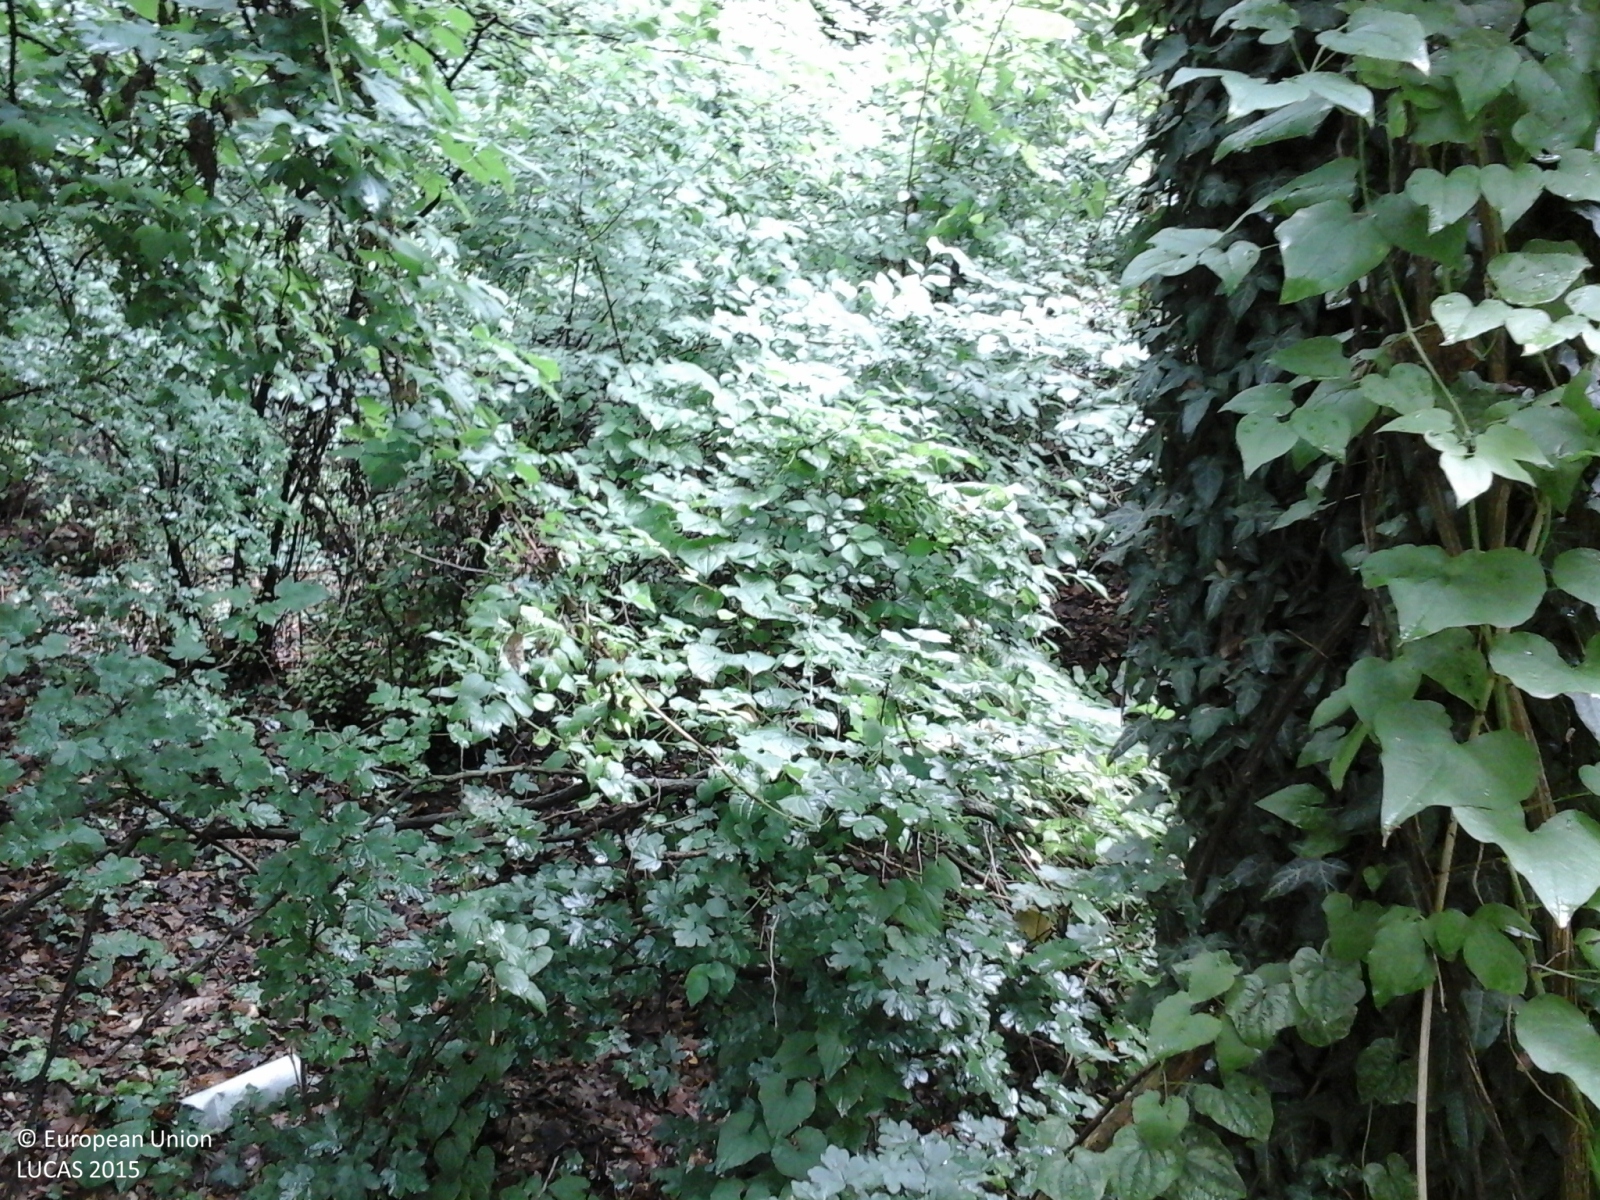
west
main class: Woodland
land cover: Broadleaved woodland
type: mesophytic deciduous forest
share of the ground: > 75 %
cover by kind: broadleaved forest trees 80 %, shrubs 15 %, herbaceous plants 5 %
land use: Semi-natural and natural areas not in use
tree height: > 5 m
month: June
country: IT
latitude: 44.3560
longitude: 11.6148
